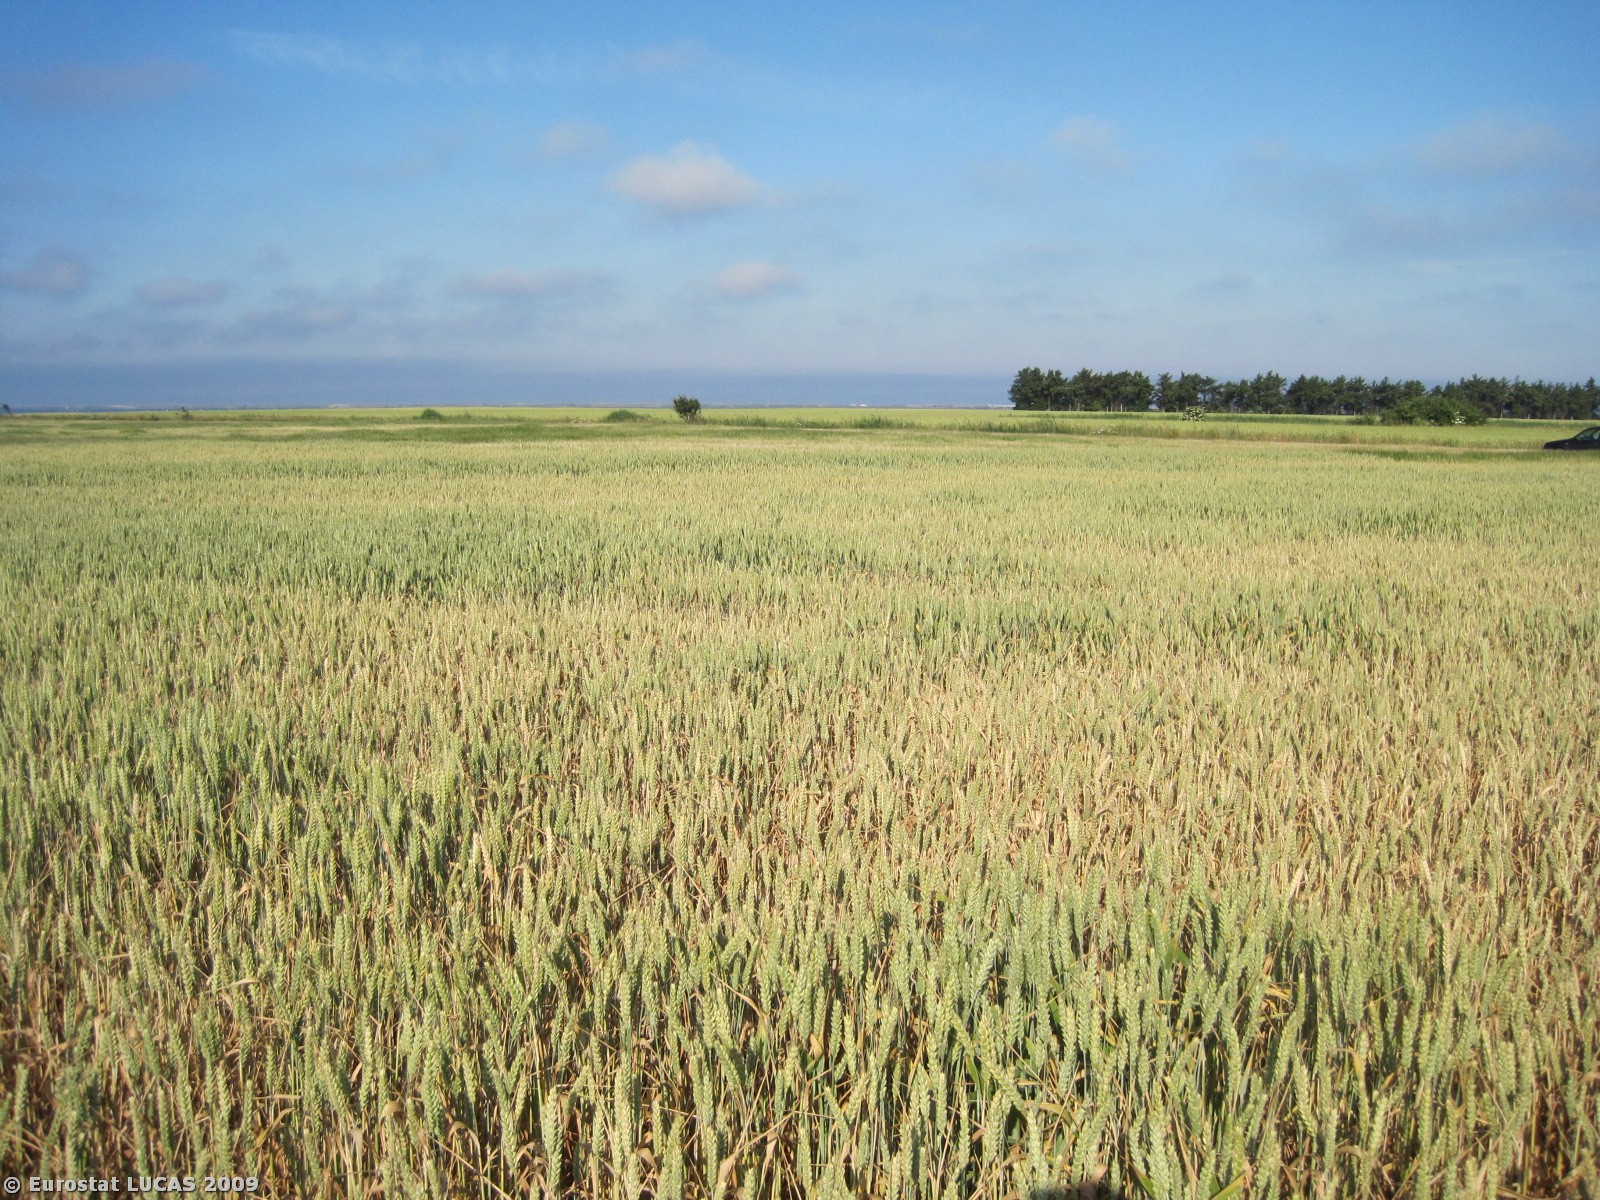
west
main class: Cropland
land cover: Common wheat
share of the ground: > 75 %
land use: Agriculture (excluding fallow land and kitchen gardens)
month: July
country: DK
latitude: 56.3730
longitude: 8.2048
